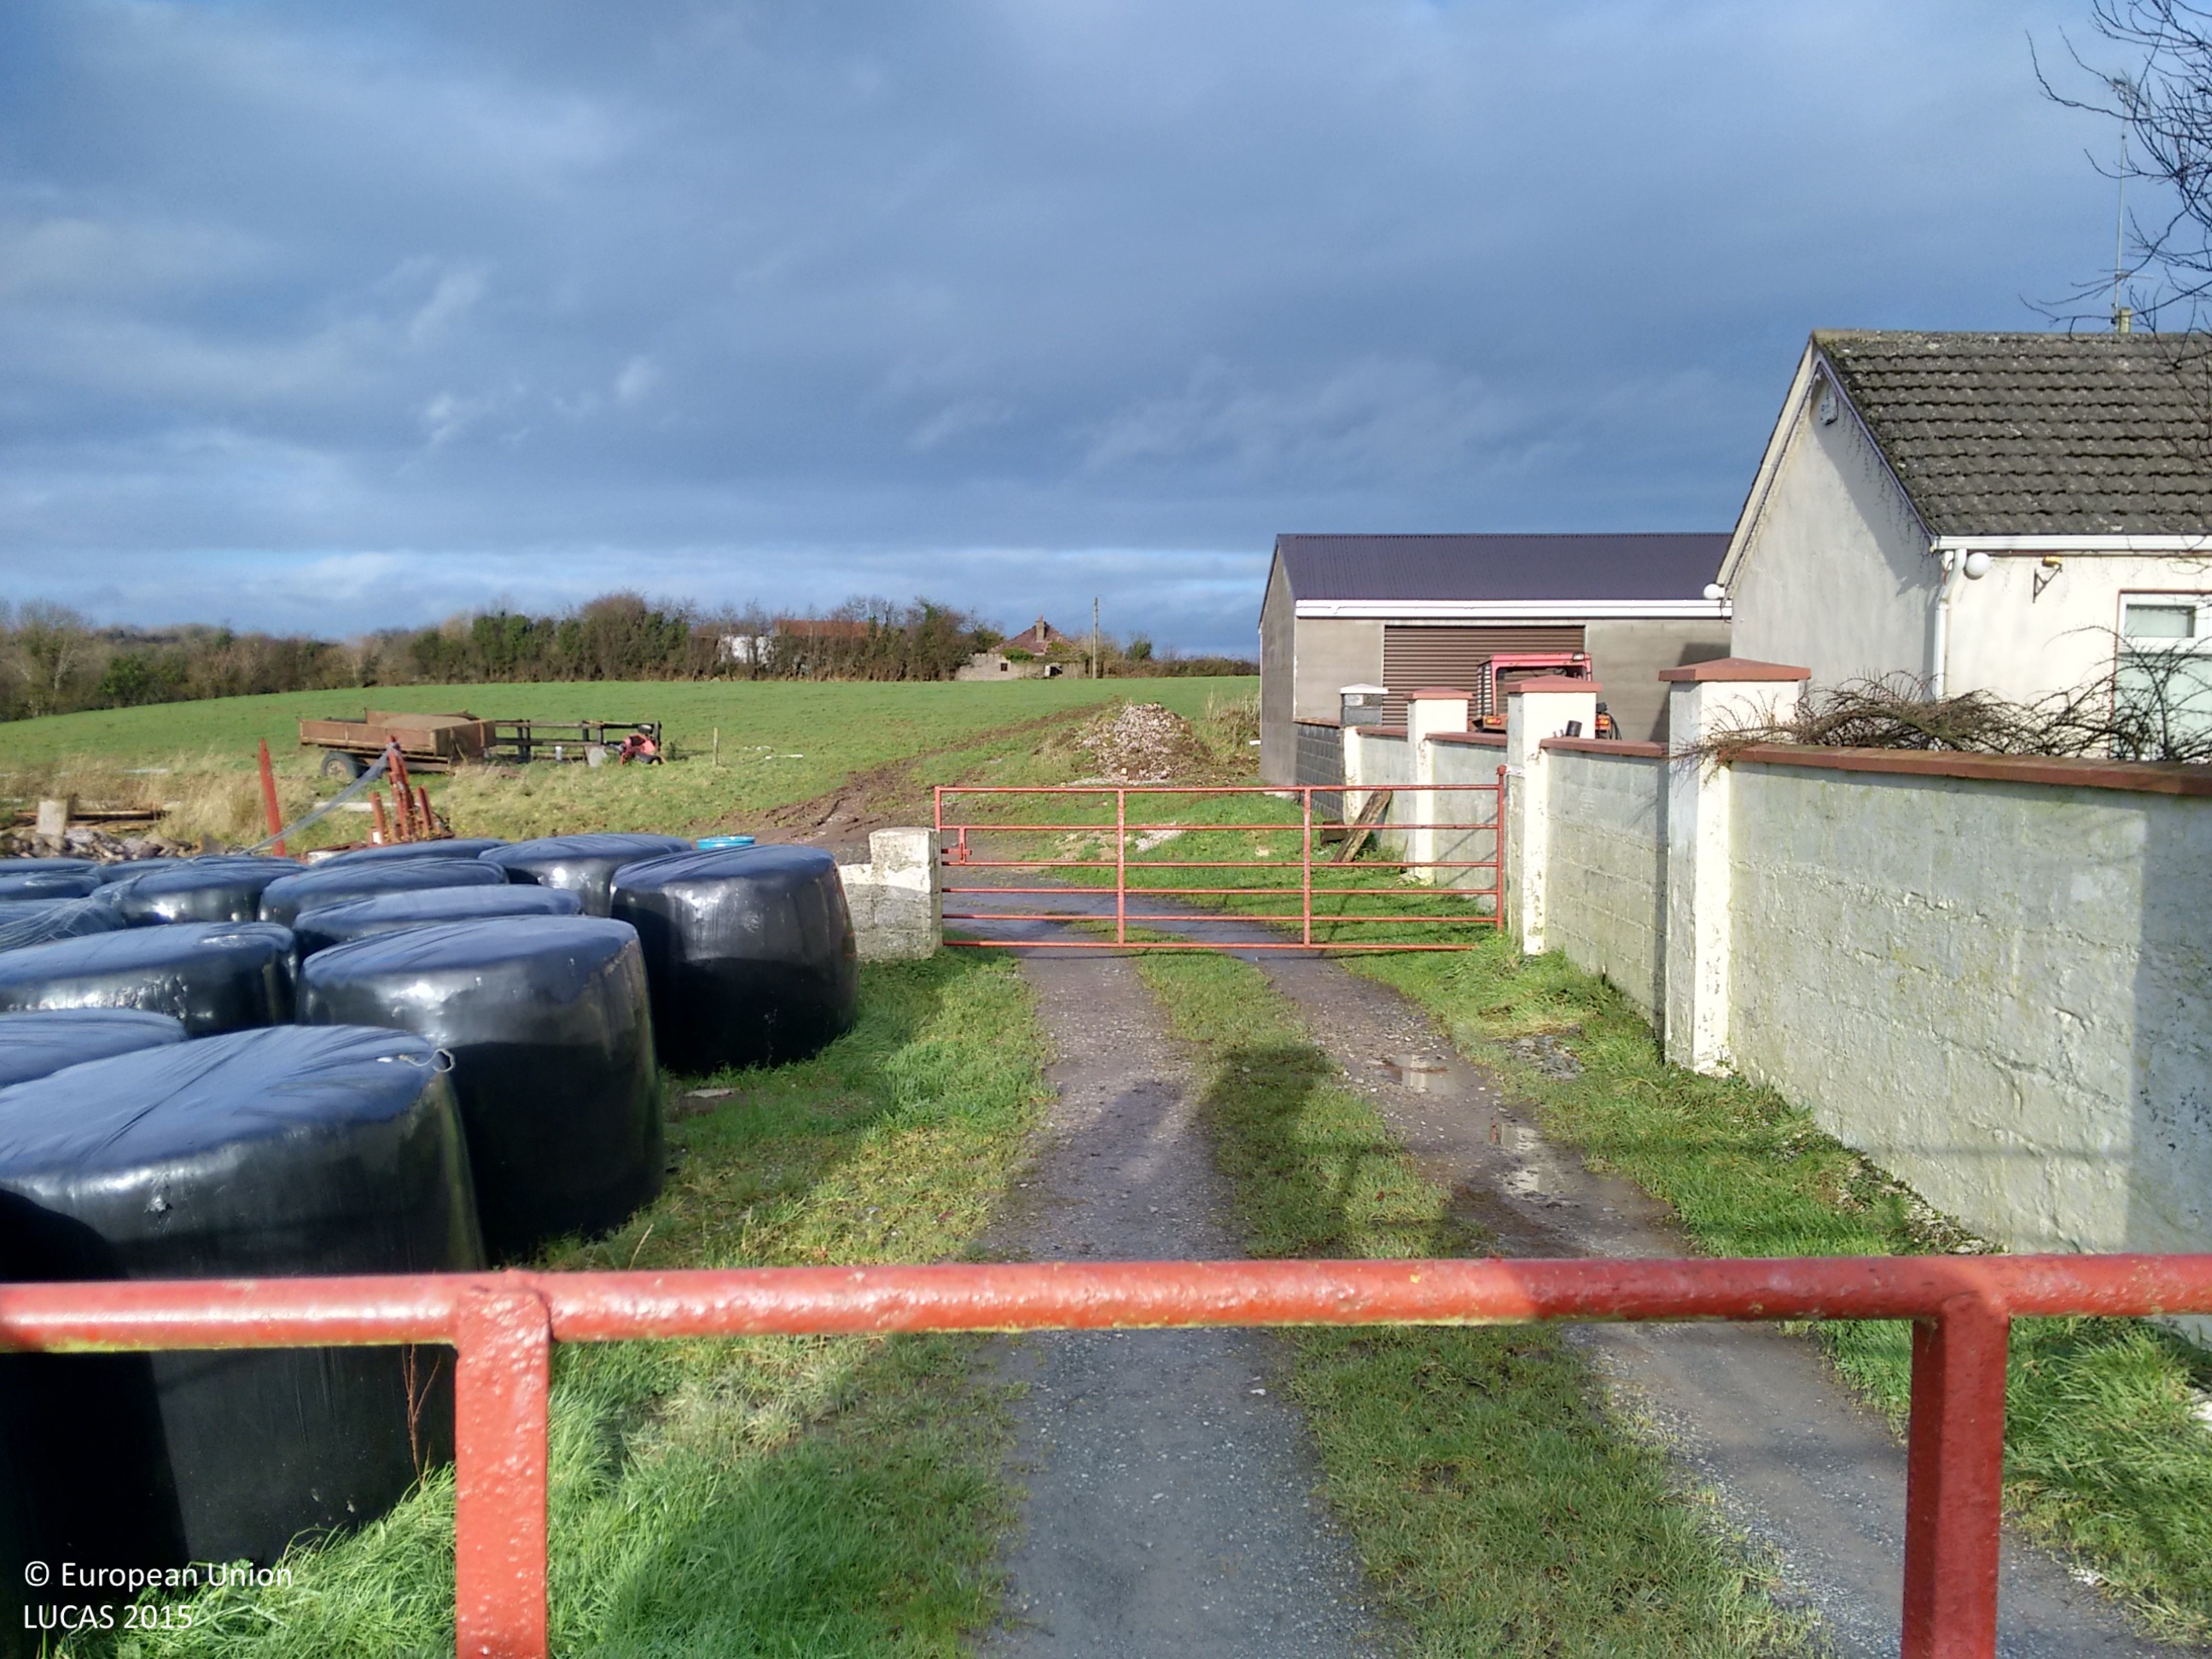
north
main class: Grassland
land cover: Grassland without tree/shrub cover
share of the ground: > 75 %
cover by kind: herbaceous plants 100 %
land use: Agriculture (excluding fallow land and kitchen gardens)
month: December
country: IE
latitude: 53.9334
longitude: -6.7507
